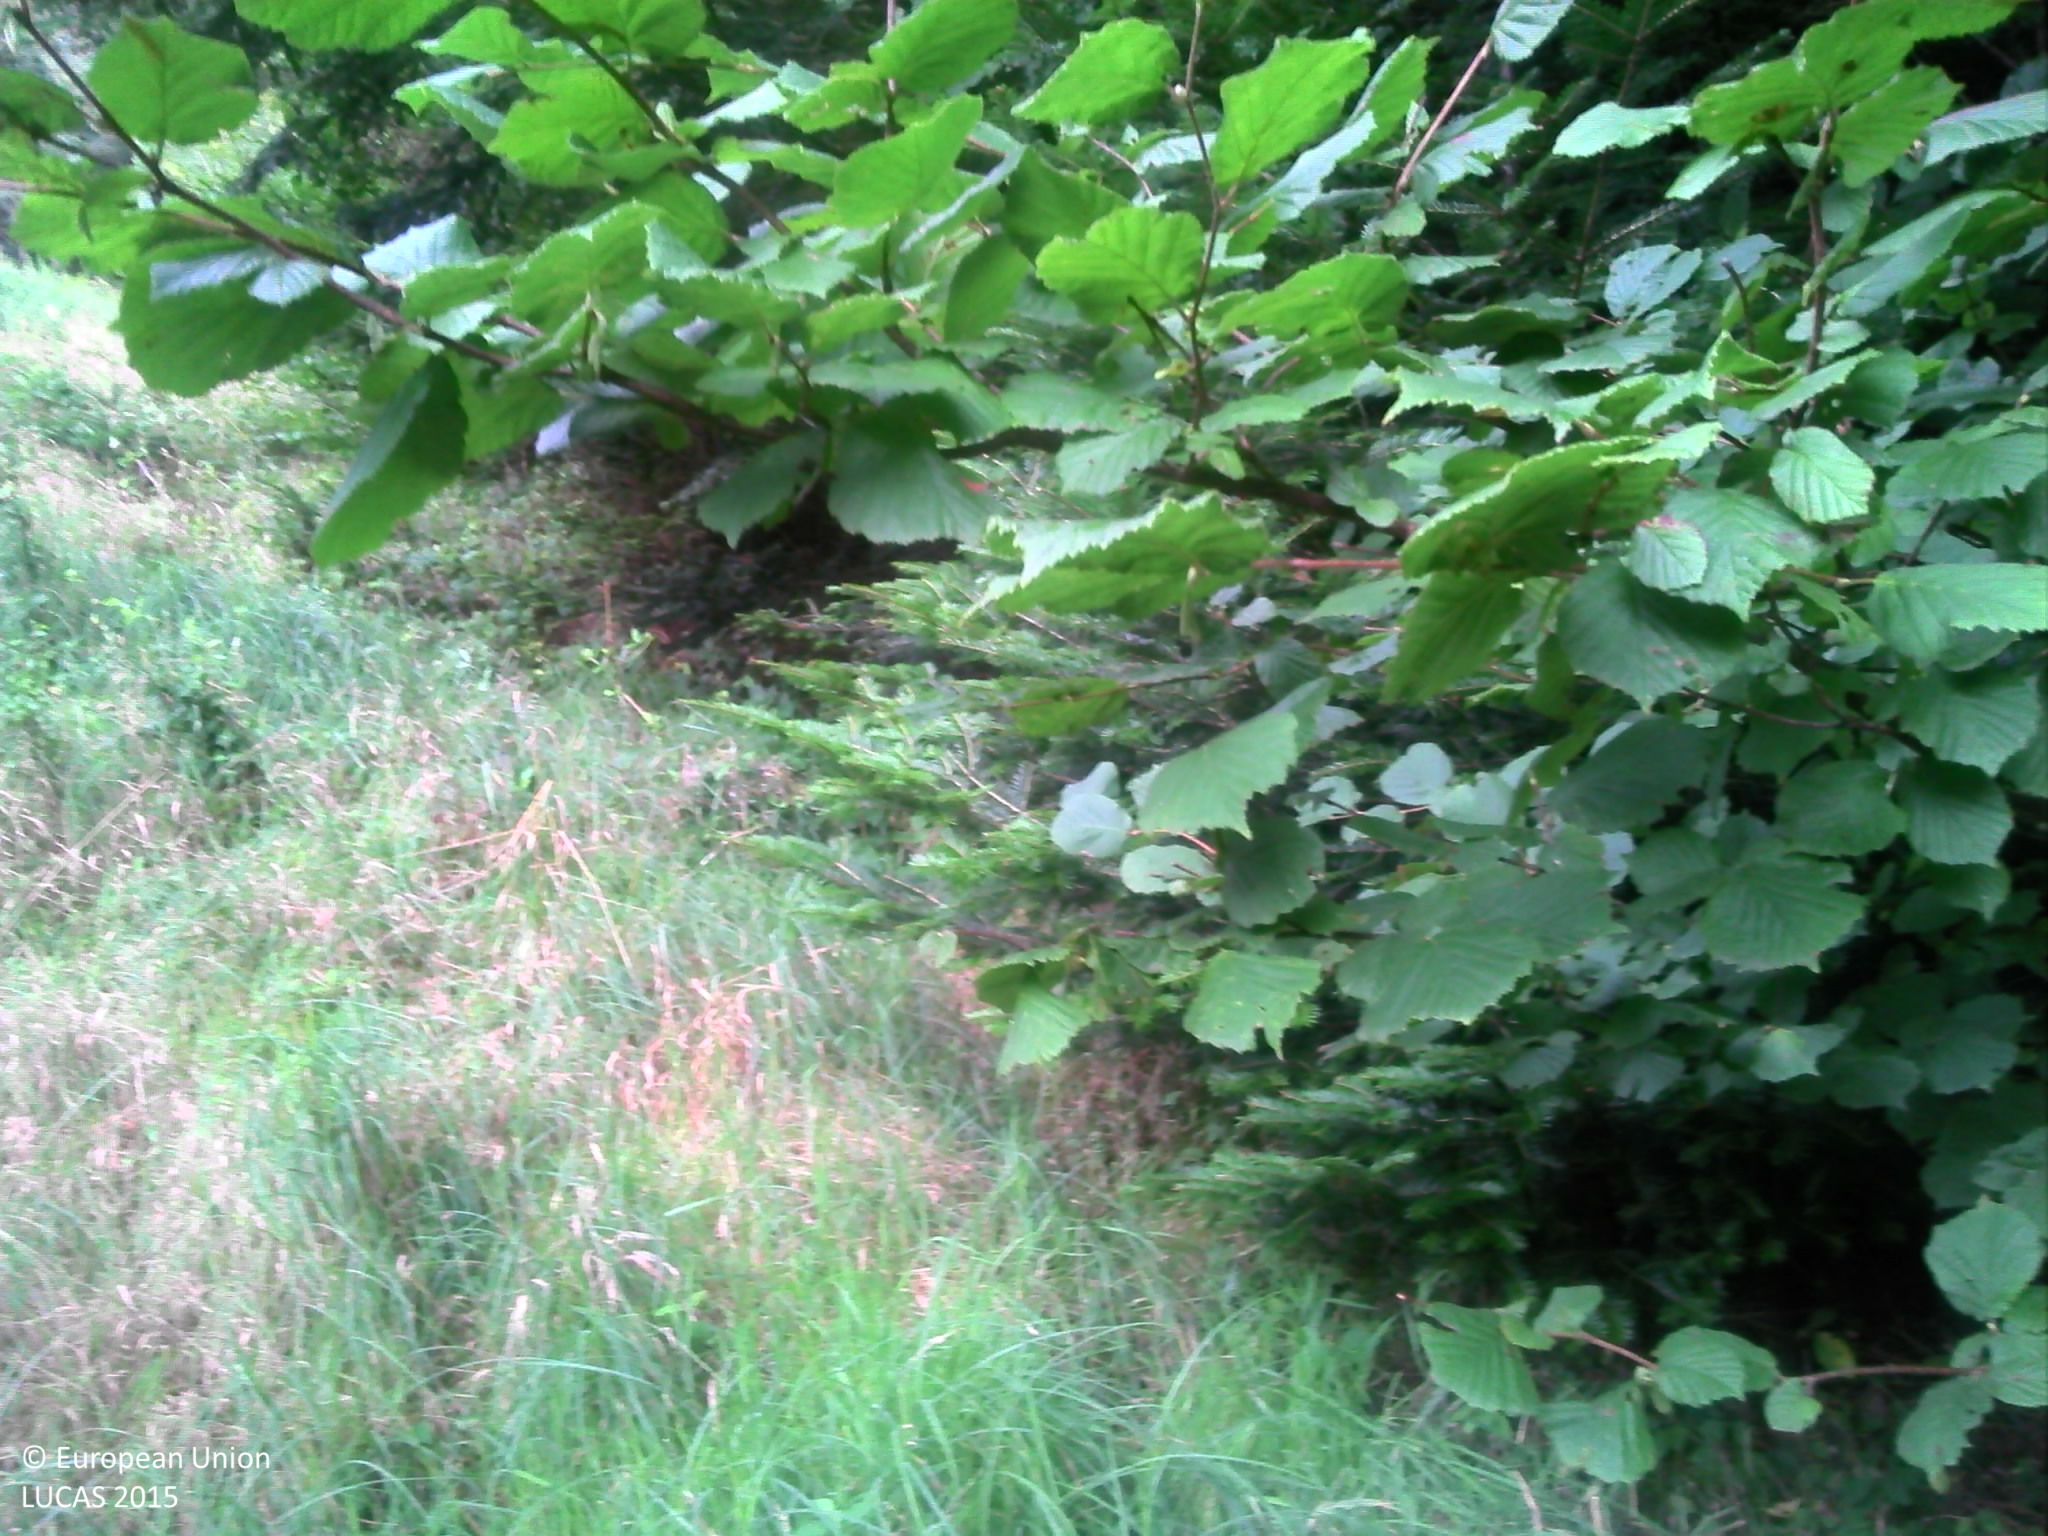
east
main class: Woodland
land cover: Spruce dominated mixed woodland
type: mountainous beech forest
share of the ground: > 75 %
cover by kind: coniferous forest trees 40 %, broadleaved forest trees 35 %, herbaceous plants 15 %, unconsolidated bare surface 10 %
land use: Forestry
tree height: > 5 m
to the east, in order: Spruce dominated mixed woodland; Tracks; Spontaneously vegetated surfaces; Spruce dominated mixed woodland; Ditches and canals; Spontaneously vegetated surfaces; Tracks; Spruce dominated mixed woodland
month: August
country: FR
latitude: 45.2034
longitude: 4.5941
